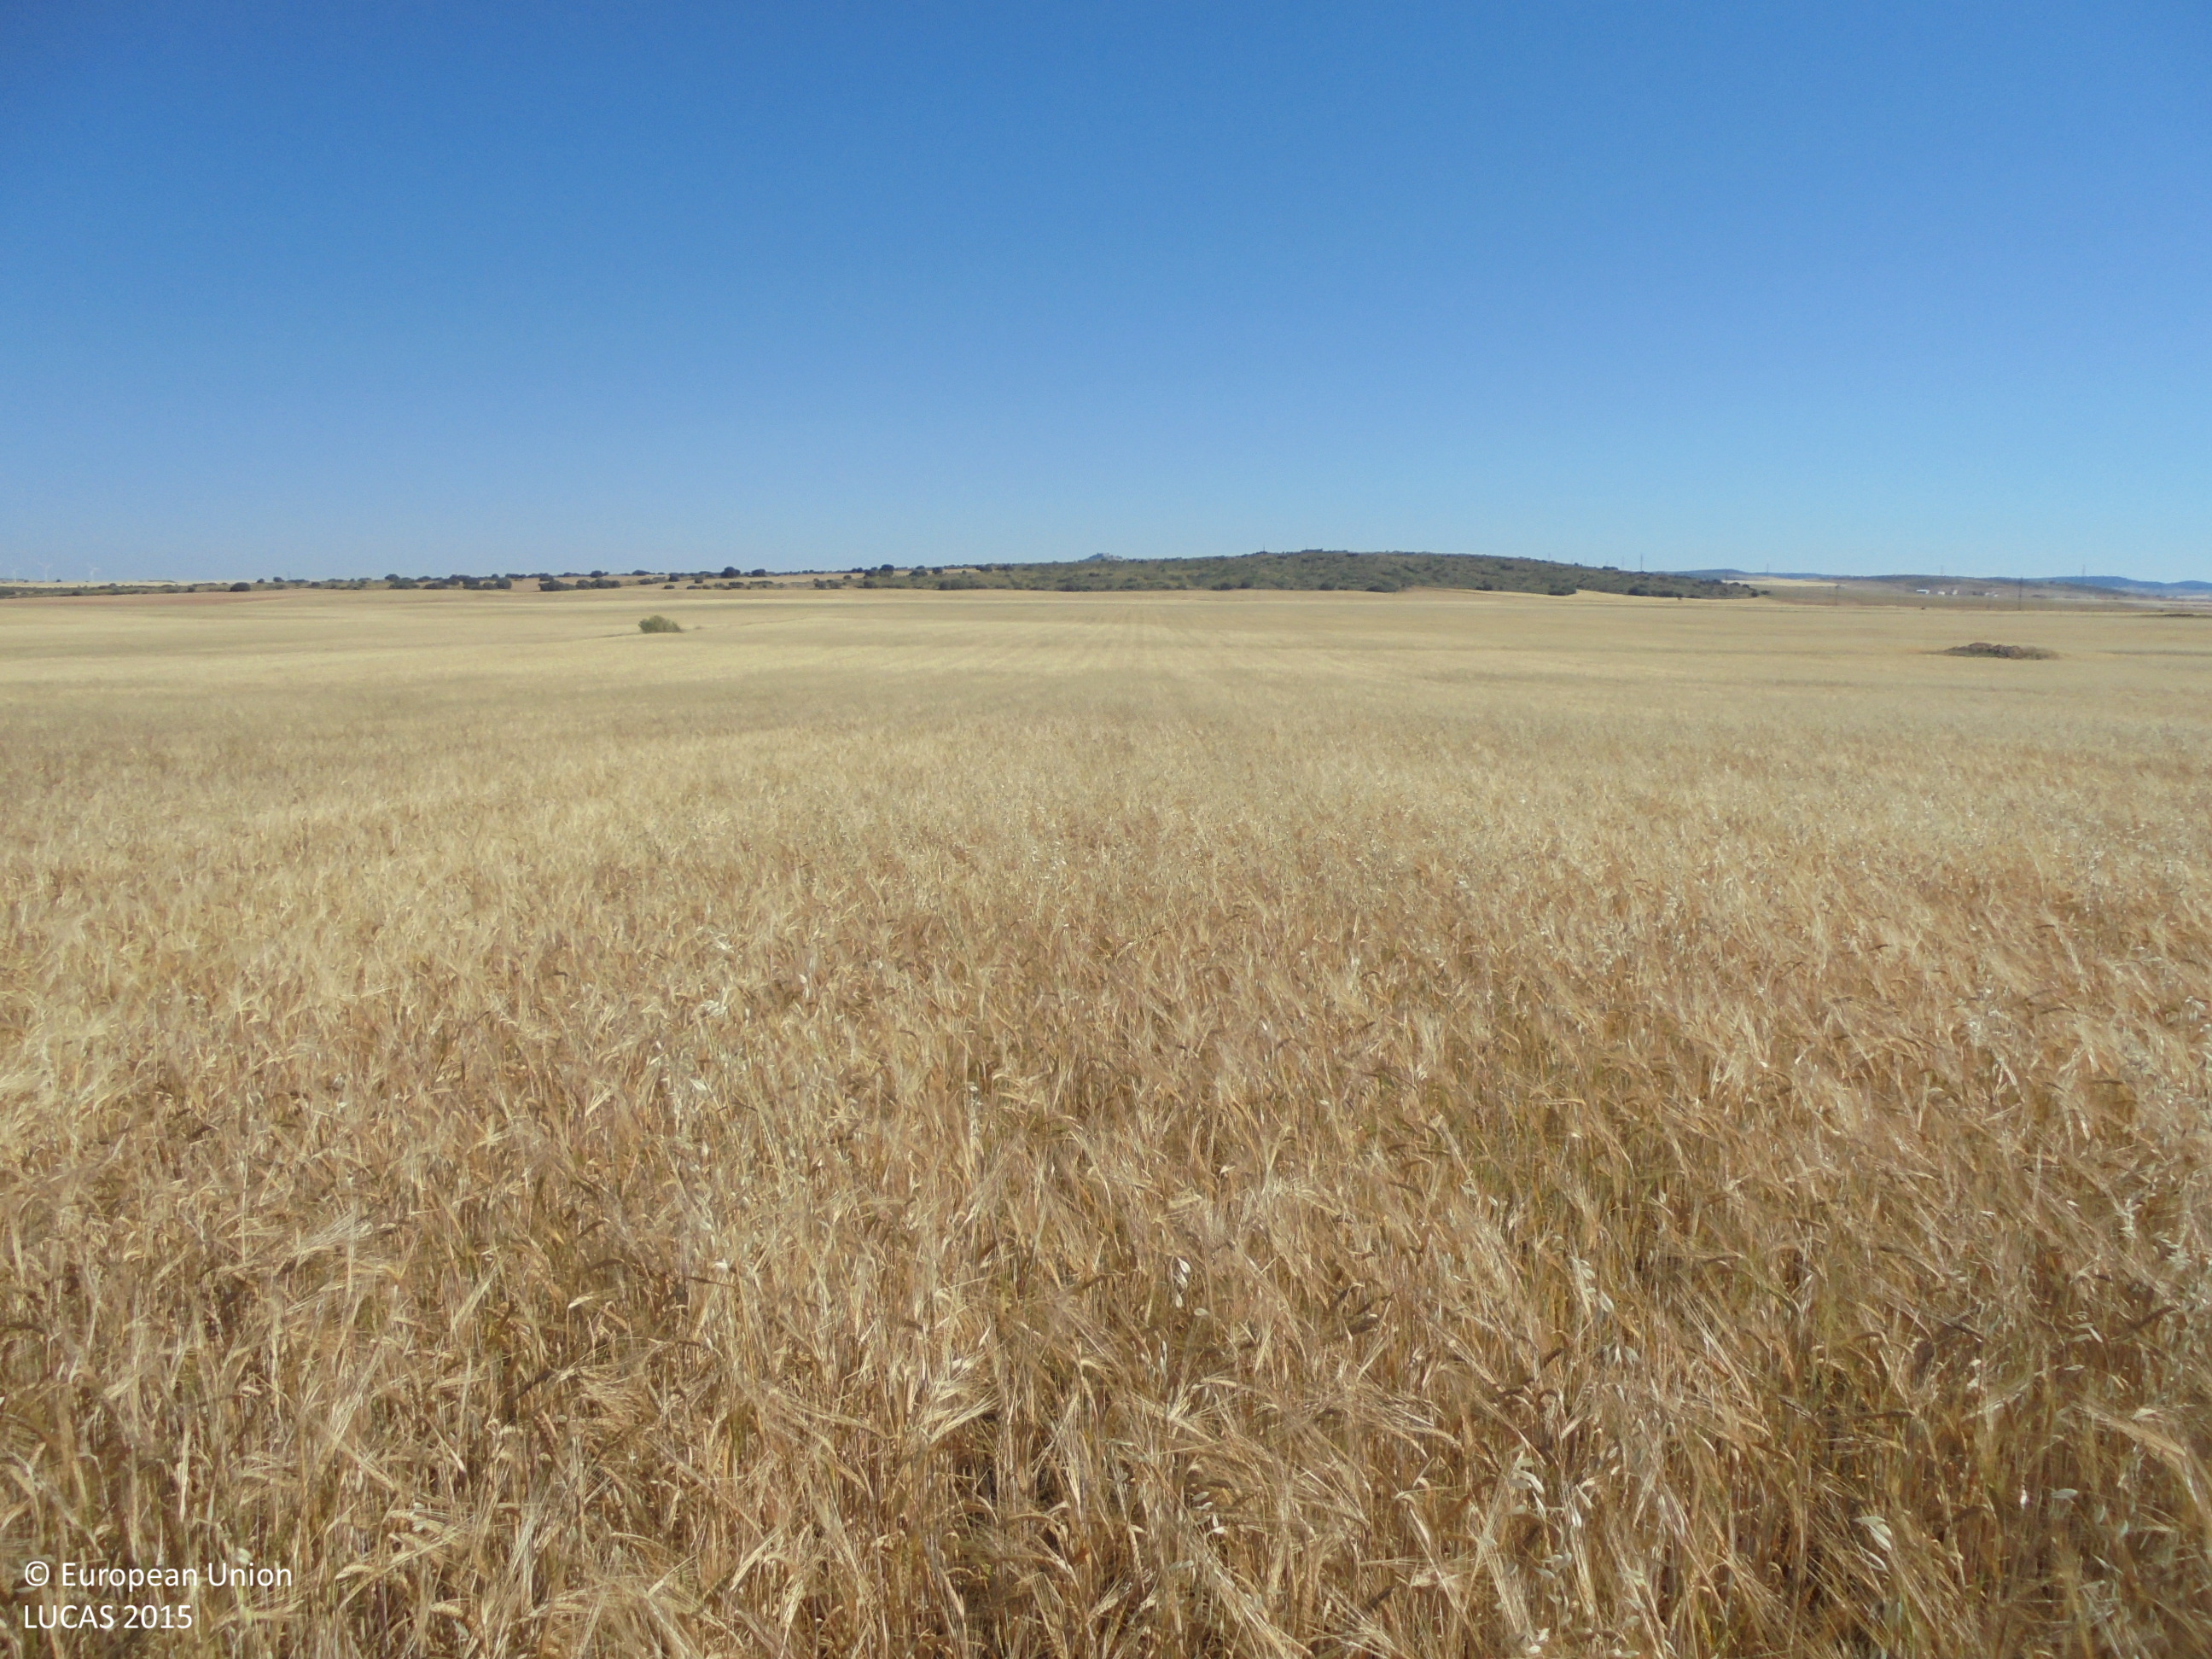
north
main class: Cropland
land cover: Barley
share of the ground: > 75 %
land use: Agriculture (excluding fallow land and kitchen gardens)
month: June
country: ES
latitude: 38.8474
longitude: -1.7387
